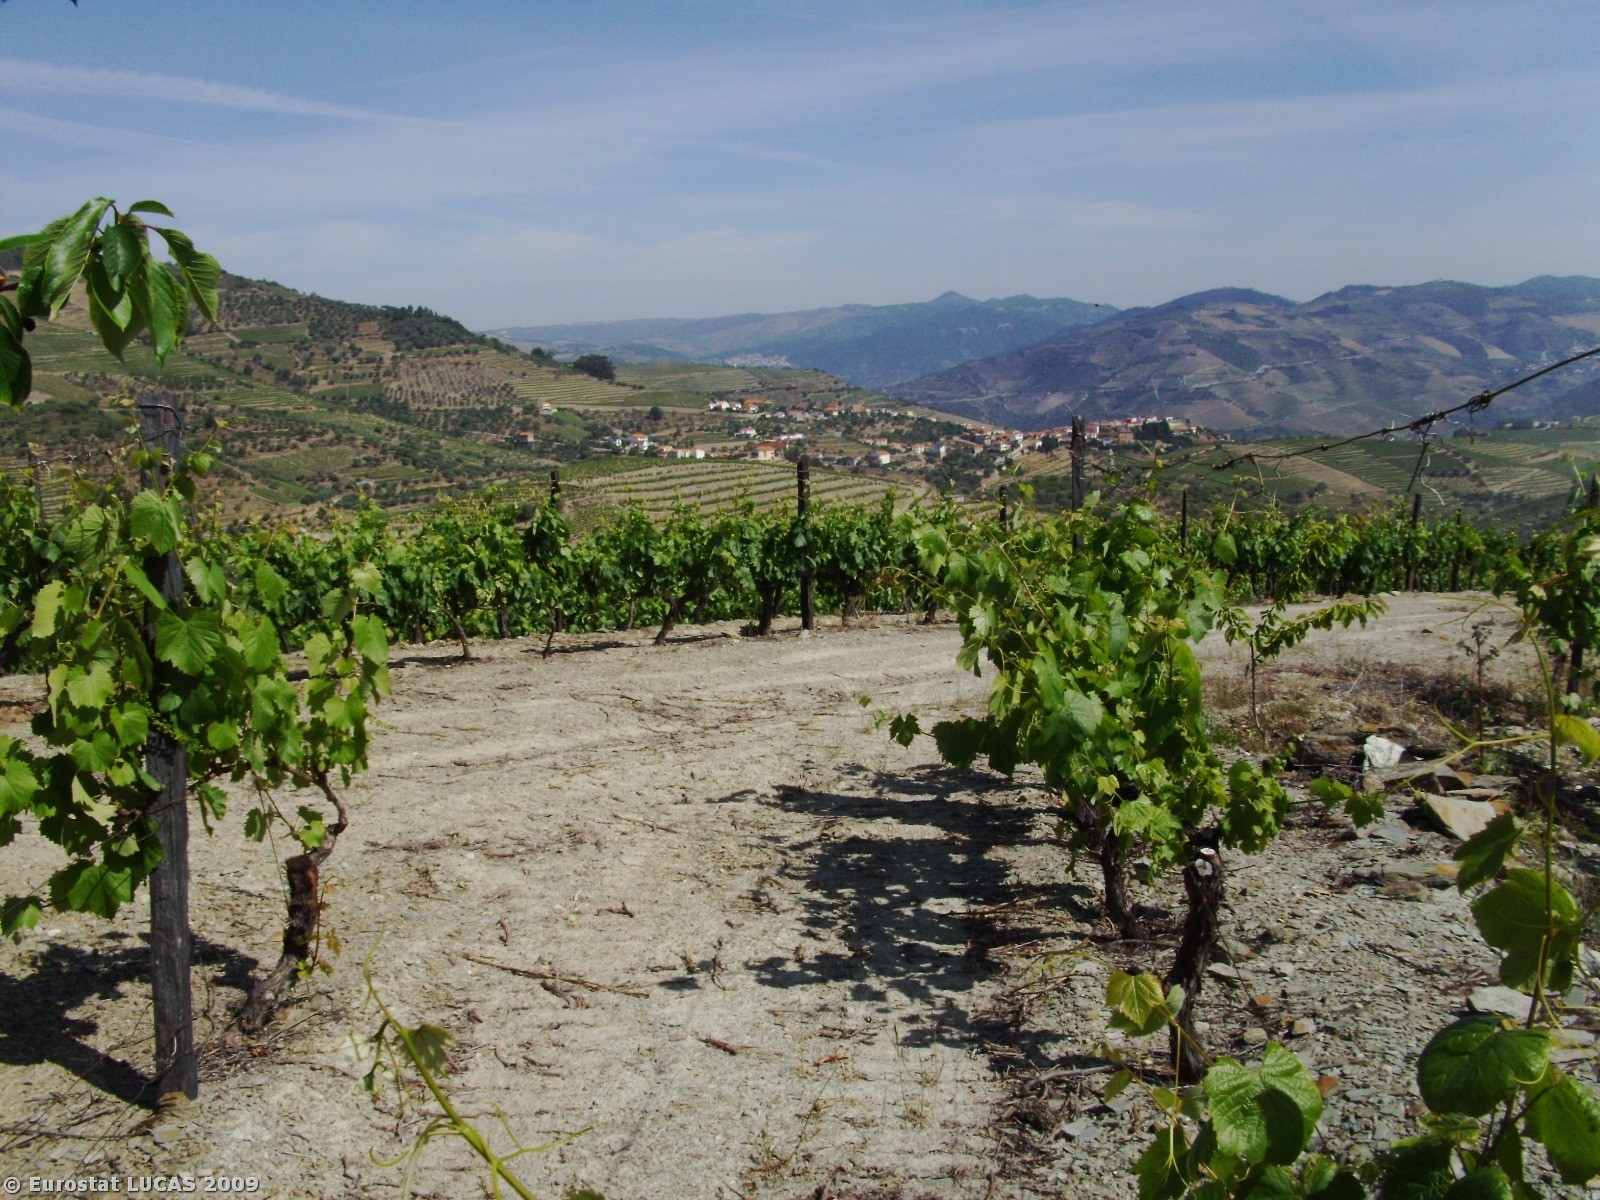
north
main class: Cropland
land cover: Vineyards
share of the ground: 10 - 25 %
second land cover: Bare land
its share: > 75 %
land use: Agriculture (excluding fallow land and kitchen gardens)
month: May
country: PT
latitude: 41.1686
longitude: -7.4141
